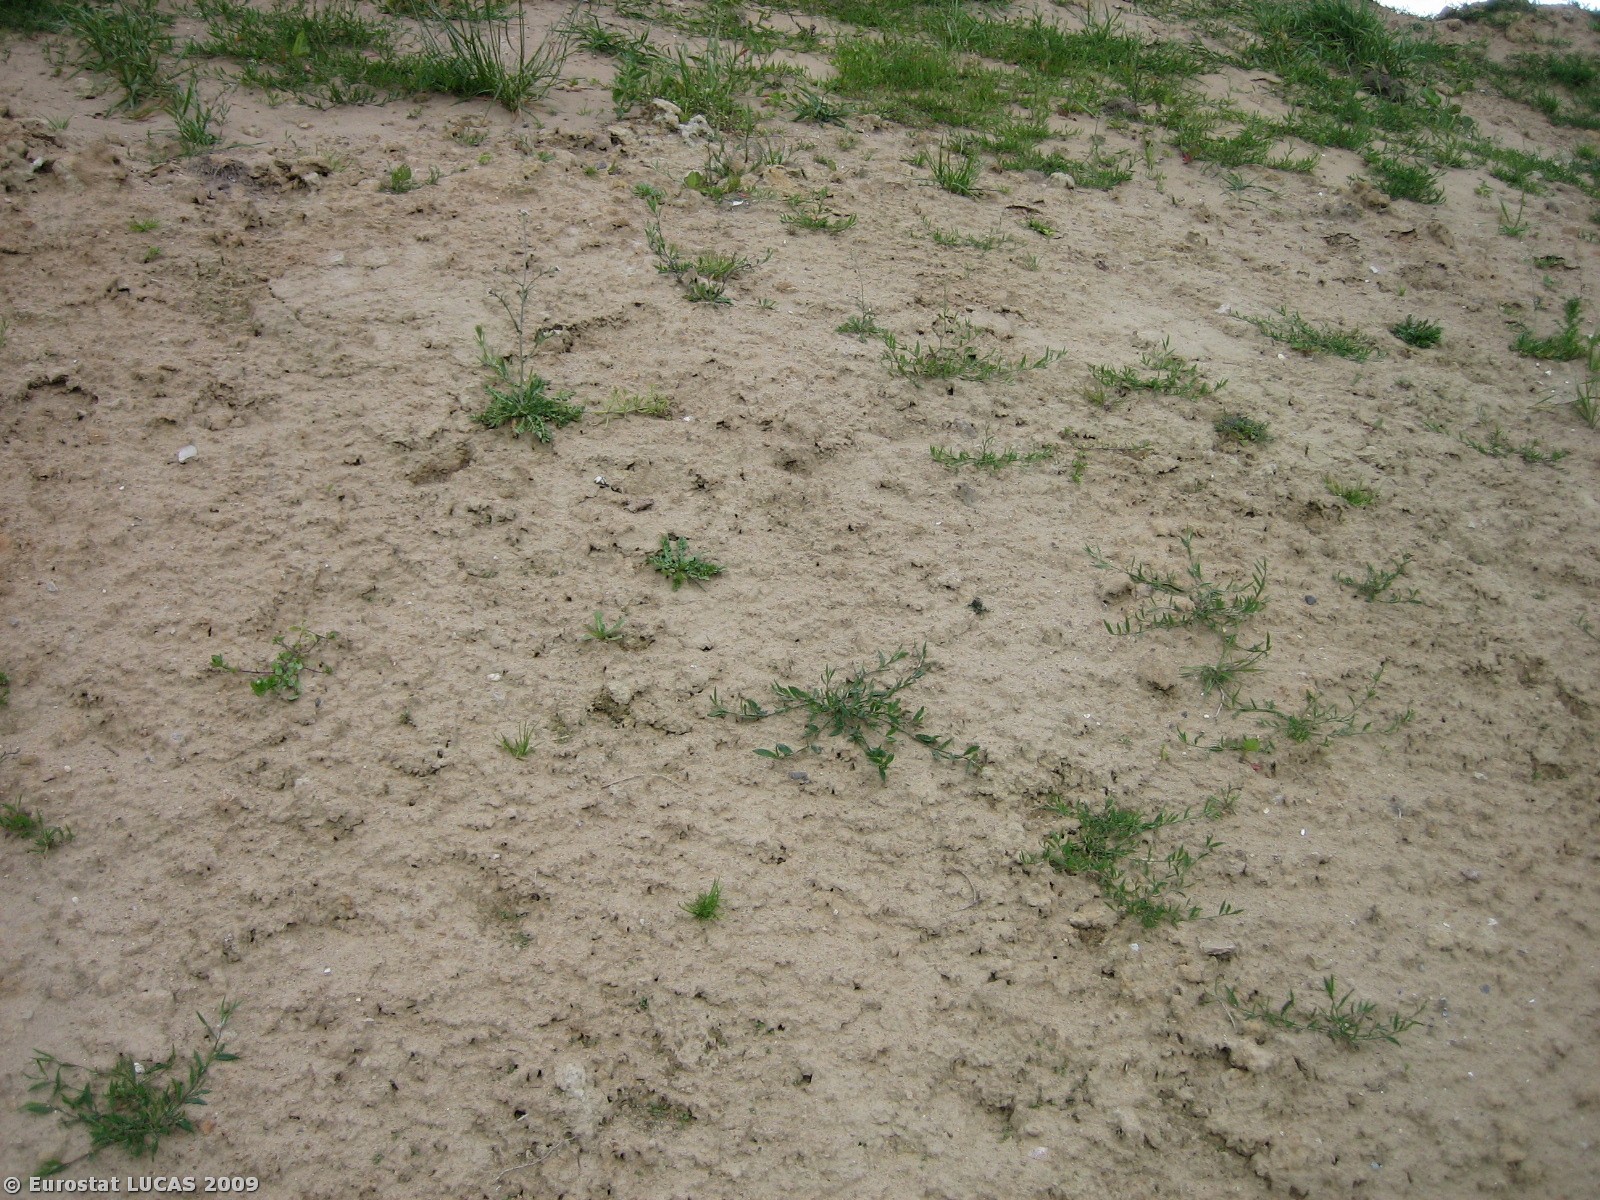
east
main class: Woodland
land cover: Broadleaved woodland
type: mesophytic deciduous forest
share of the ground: > 75 %
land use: Forestry
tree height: > 5 m
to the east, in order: Broadleaved woodland; Grassland with sparse tree/shrub cover; Bare land; Spontaneously vegetated surfaces; Grassland without tree/shrub cover; Tracks; Temporary grasslands; Fences; Grass margins; Tracks; Grass margins; Coniferous woodland; Fences; Grass margins; Temporary grasslands
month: June
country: DK
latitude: 55.6102
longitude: 9.2229
